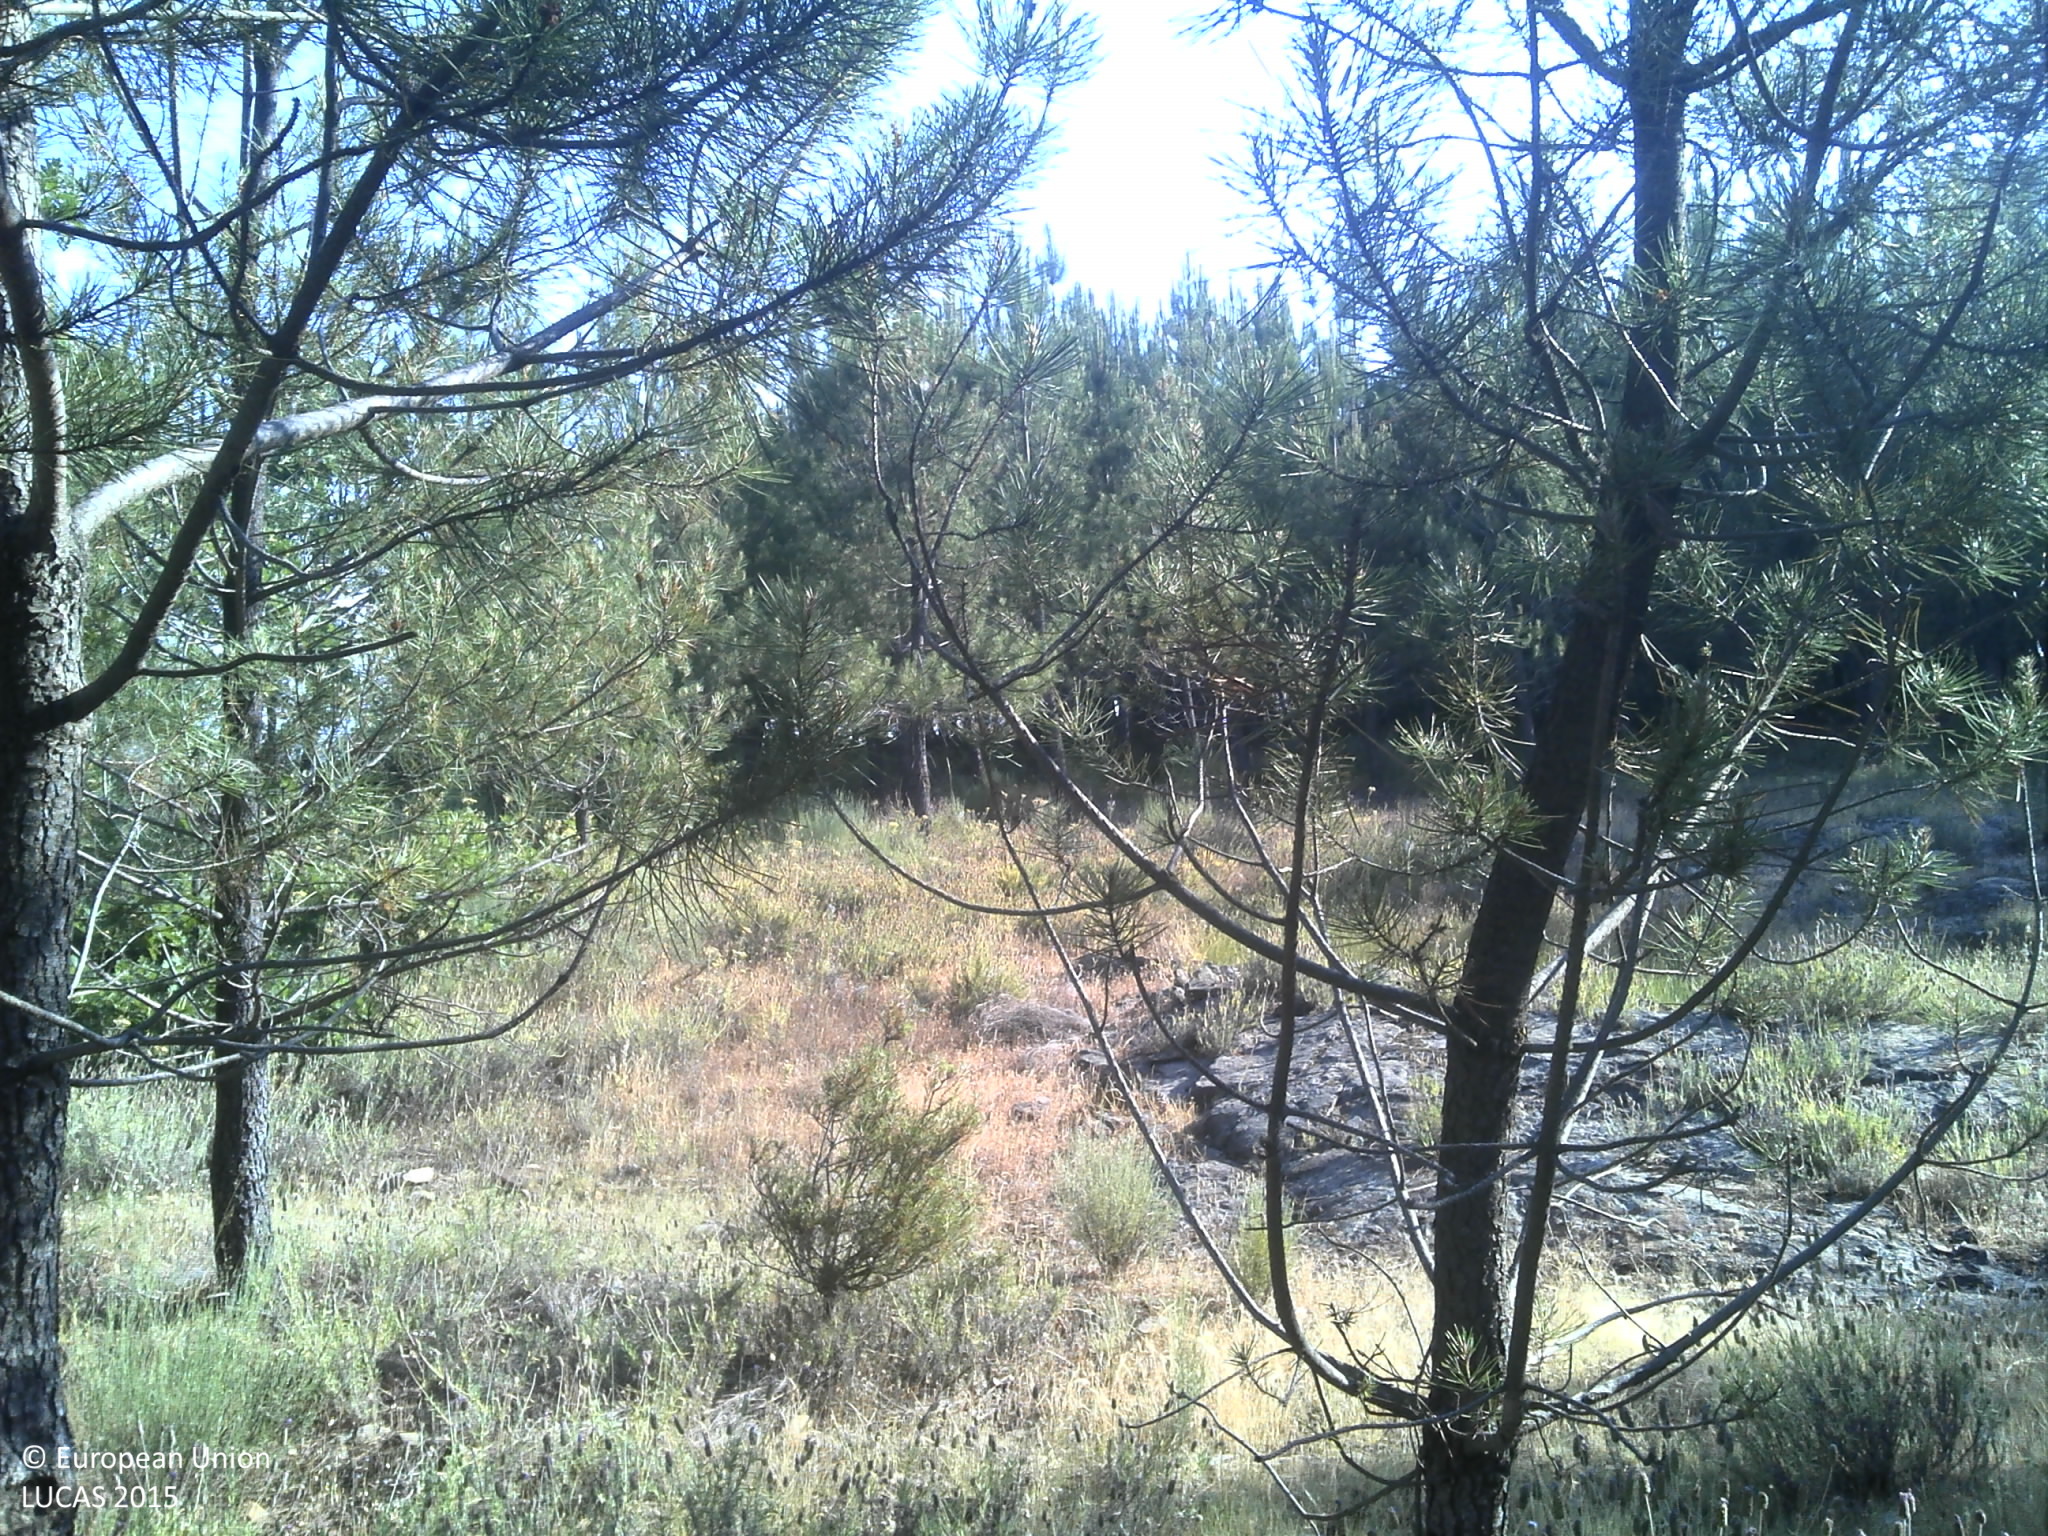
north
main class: Woodland
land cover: Pine dominated coniferous woodland
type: coniferous forest of the mediterranean region
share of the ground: 50 - 75 %
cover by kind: coniferous forest trees 65 %, unconsolidated bare surface 30 %, shrubs 5 %
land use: Forestry
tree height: > 5 m
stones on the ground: 10 - 25 %
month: June
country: PT
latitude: 40.3365
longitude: -7.0117
